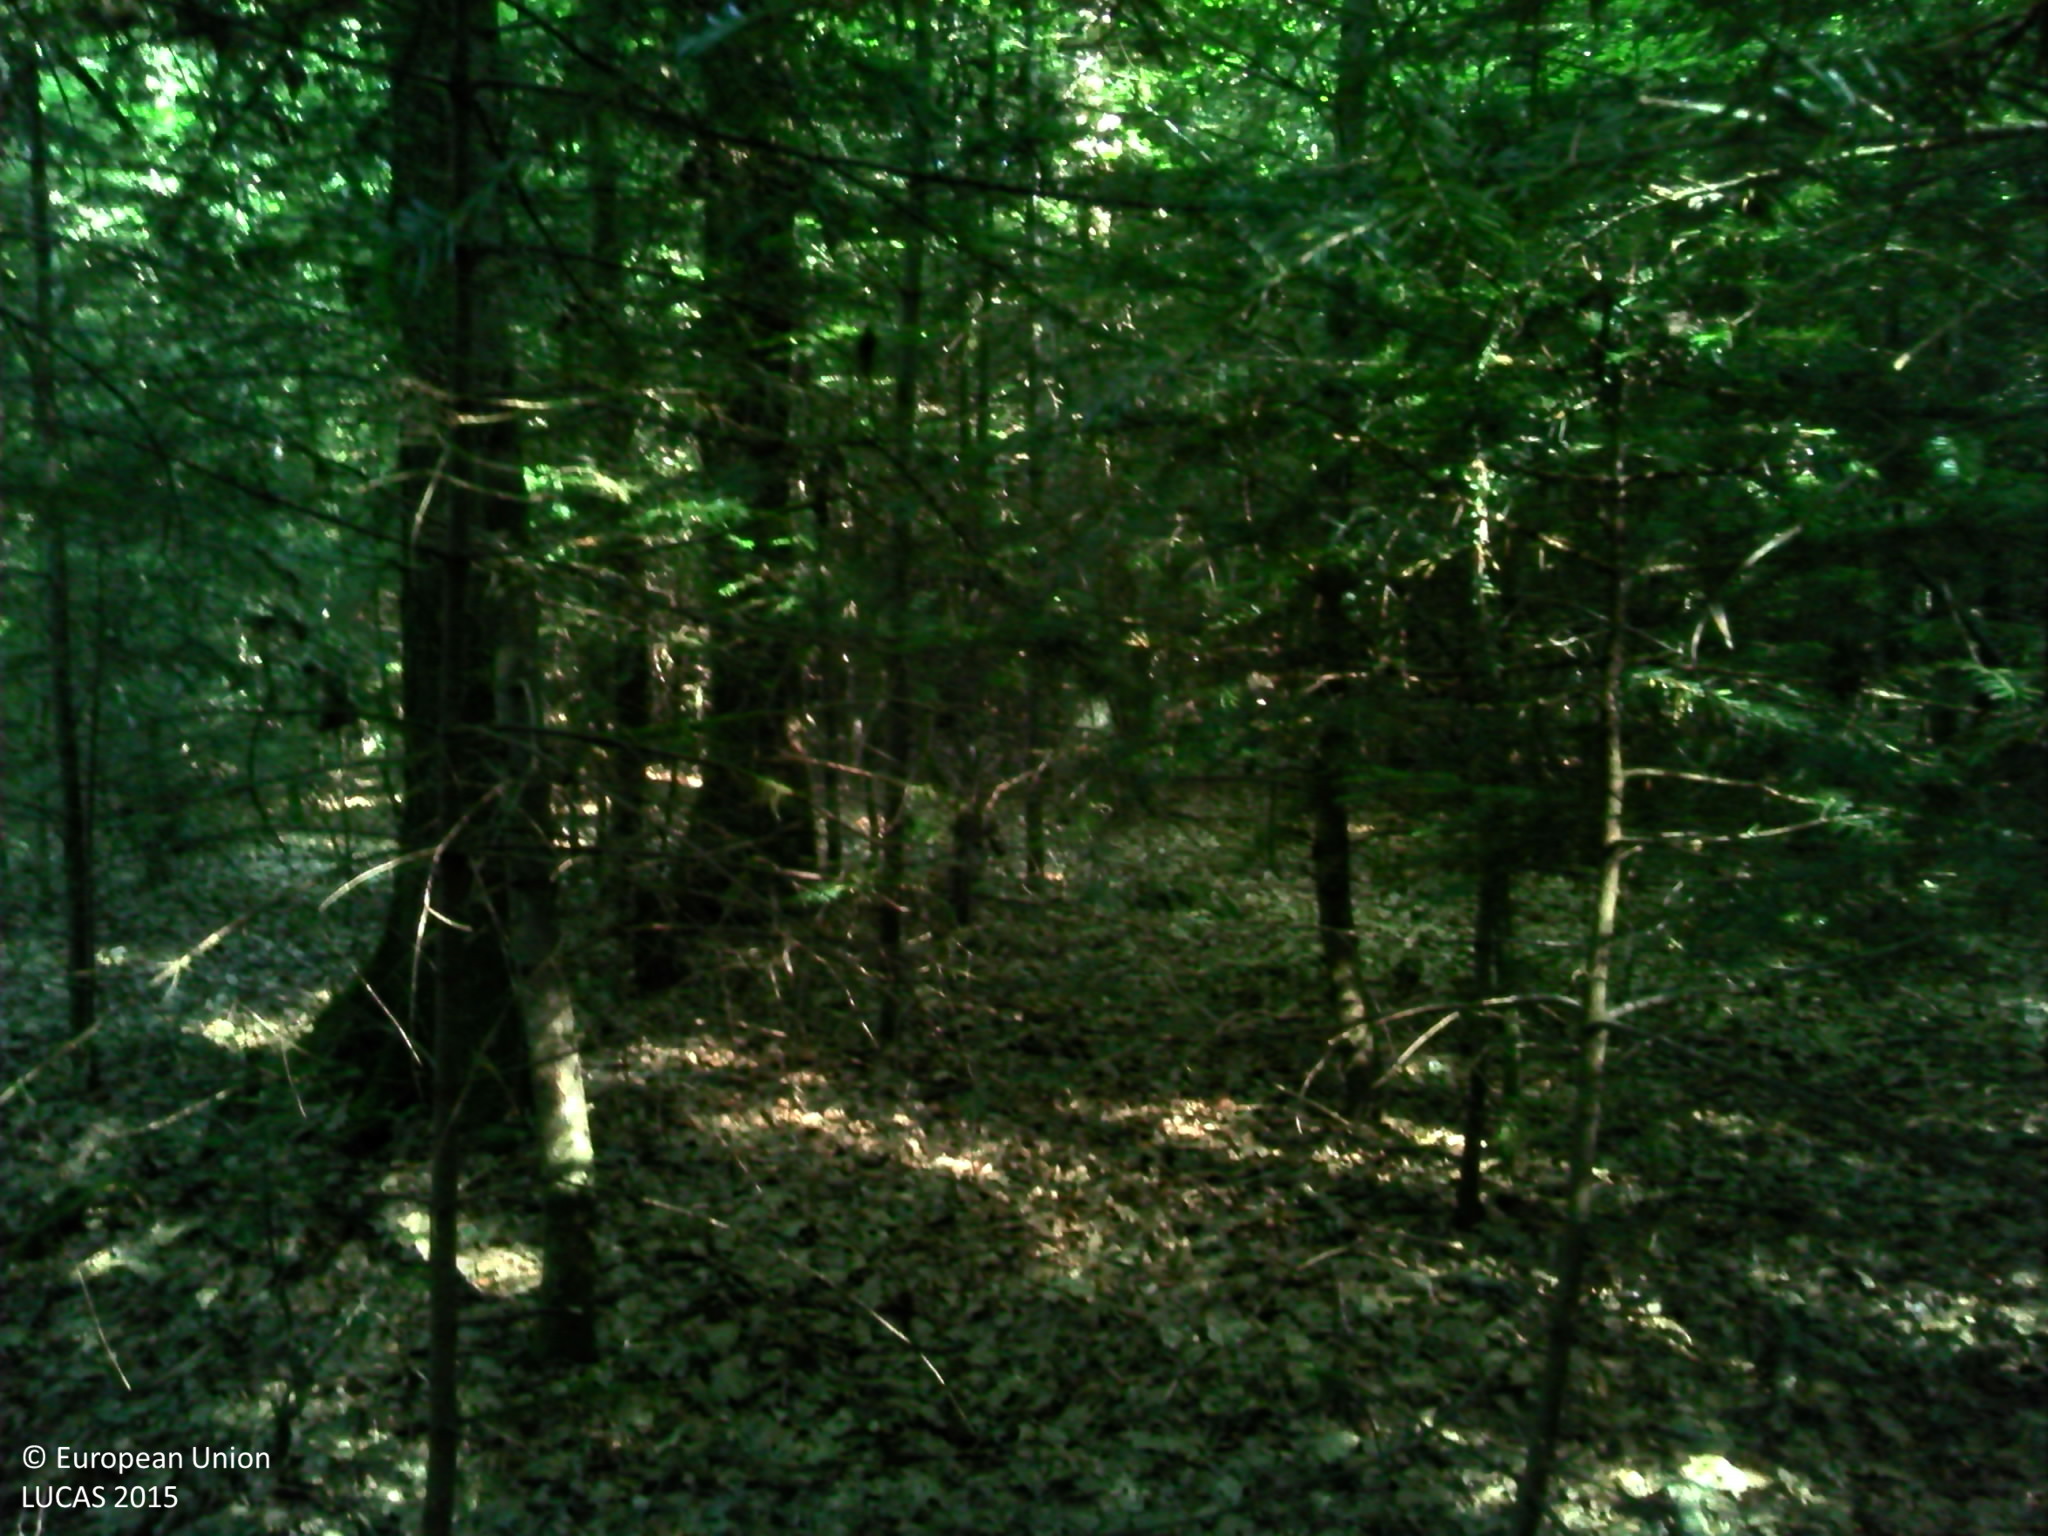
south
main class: Woodland
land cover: Spruce dominated mixed woodland
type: mesophytic deciduous forest
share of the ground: > 75 %
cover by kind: coniferous forest trees 40 %, broadleaved forest trees 30 %, herbaceous plants 15 %, consolidated bare surface 10 %, lichens and mosses 5 %
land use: Forestry
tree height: > 5 m
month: June
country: FR
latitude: 49.1174
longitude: 1.1697
